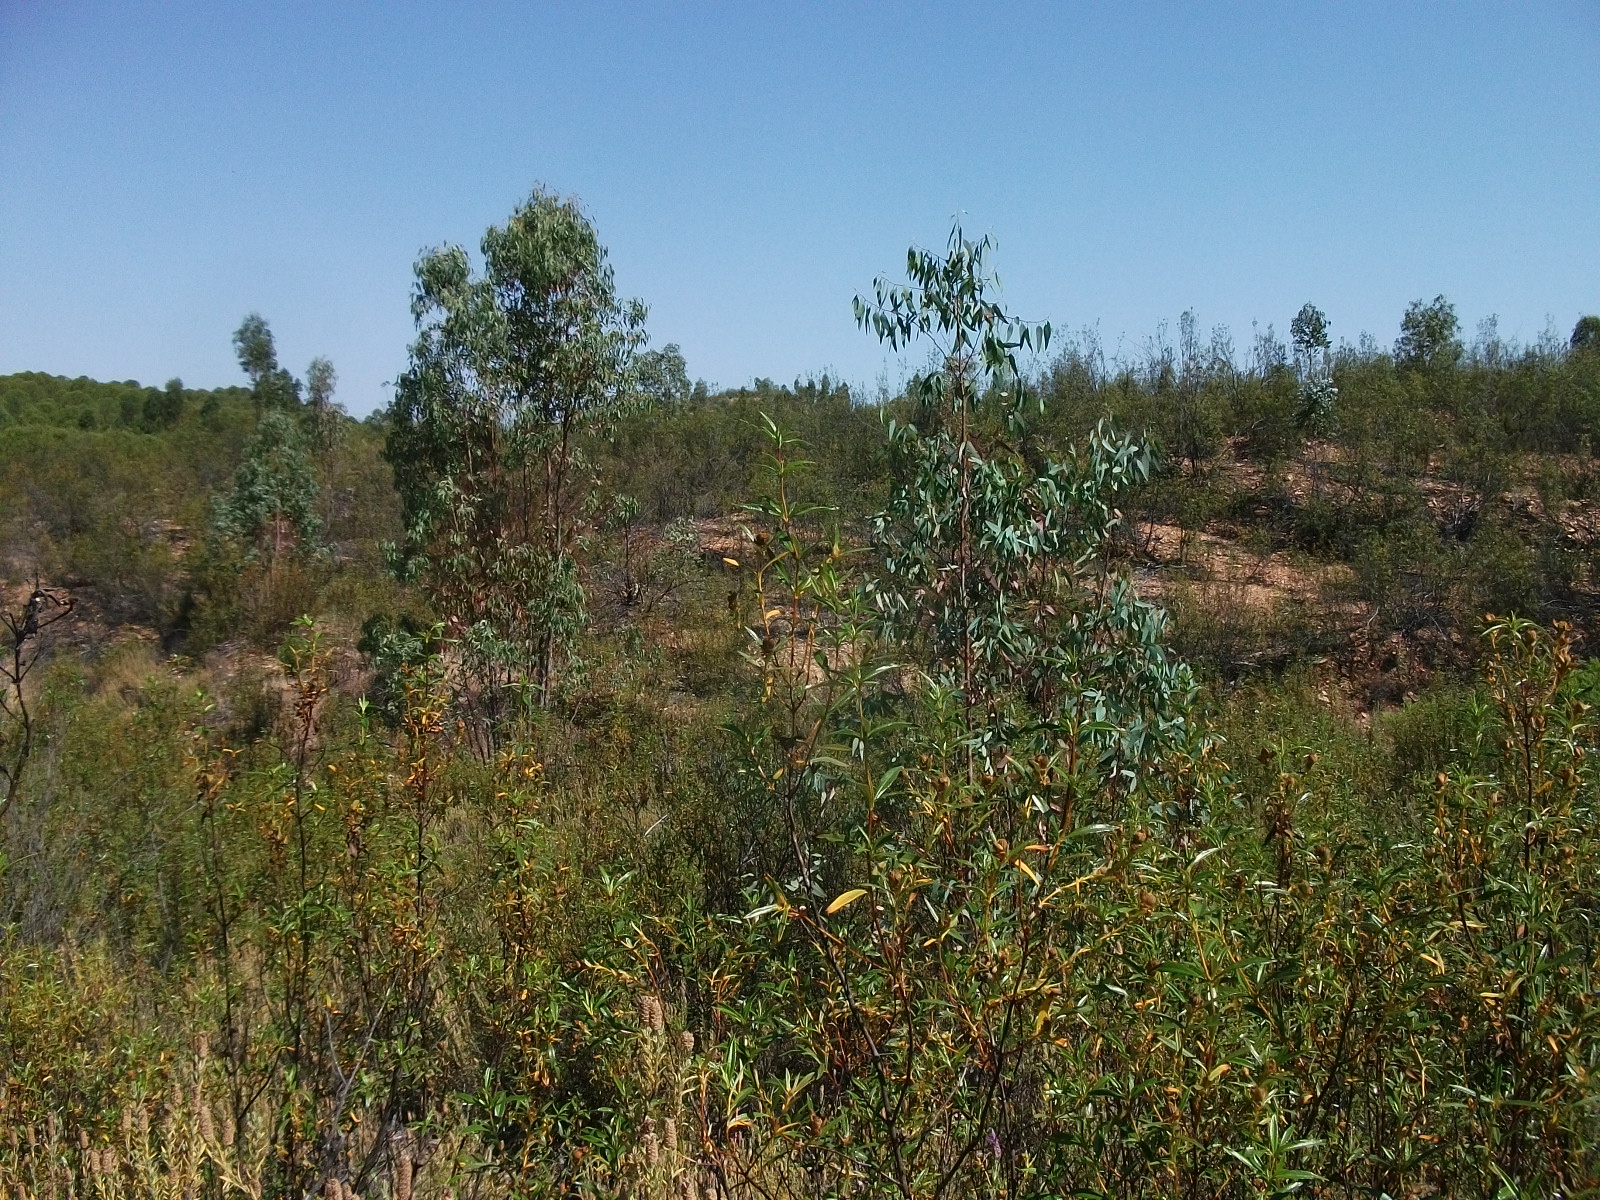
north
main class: Woodland
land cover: Broadleaved woodland
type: exotic forest
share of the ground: 10 - 25 %
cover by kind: shrubs 80 %, broadleaved forest trees 20 %
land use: Forestry
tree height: < 5 m
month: June
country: ES
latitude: 37.4868
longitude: -6.6509
